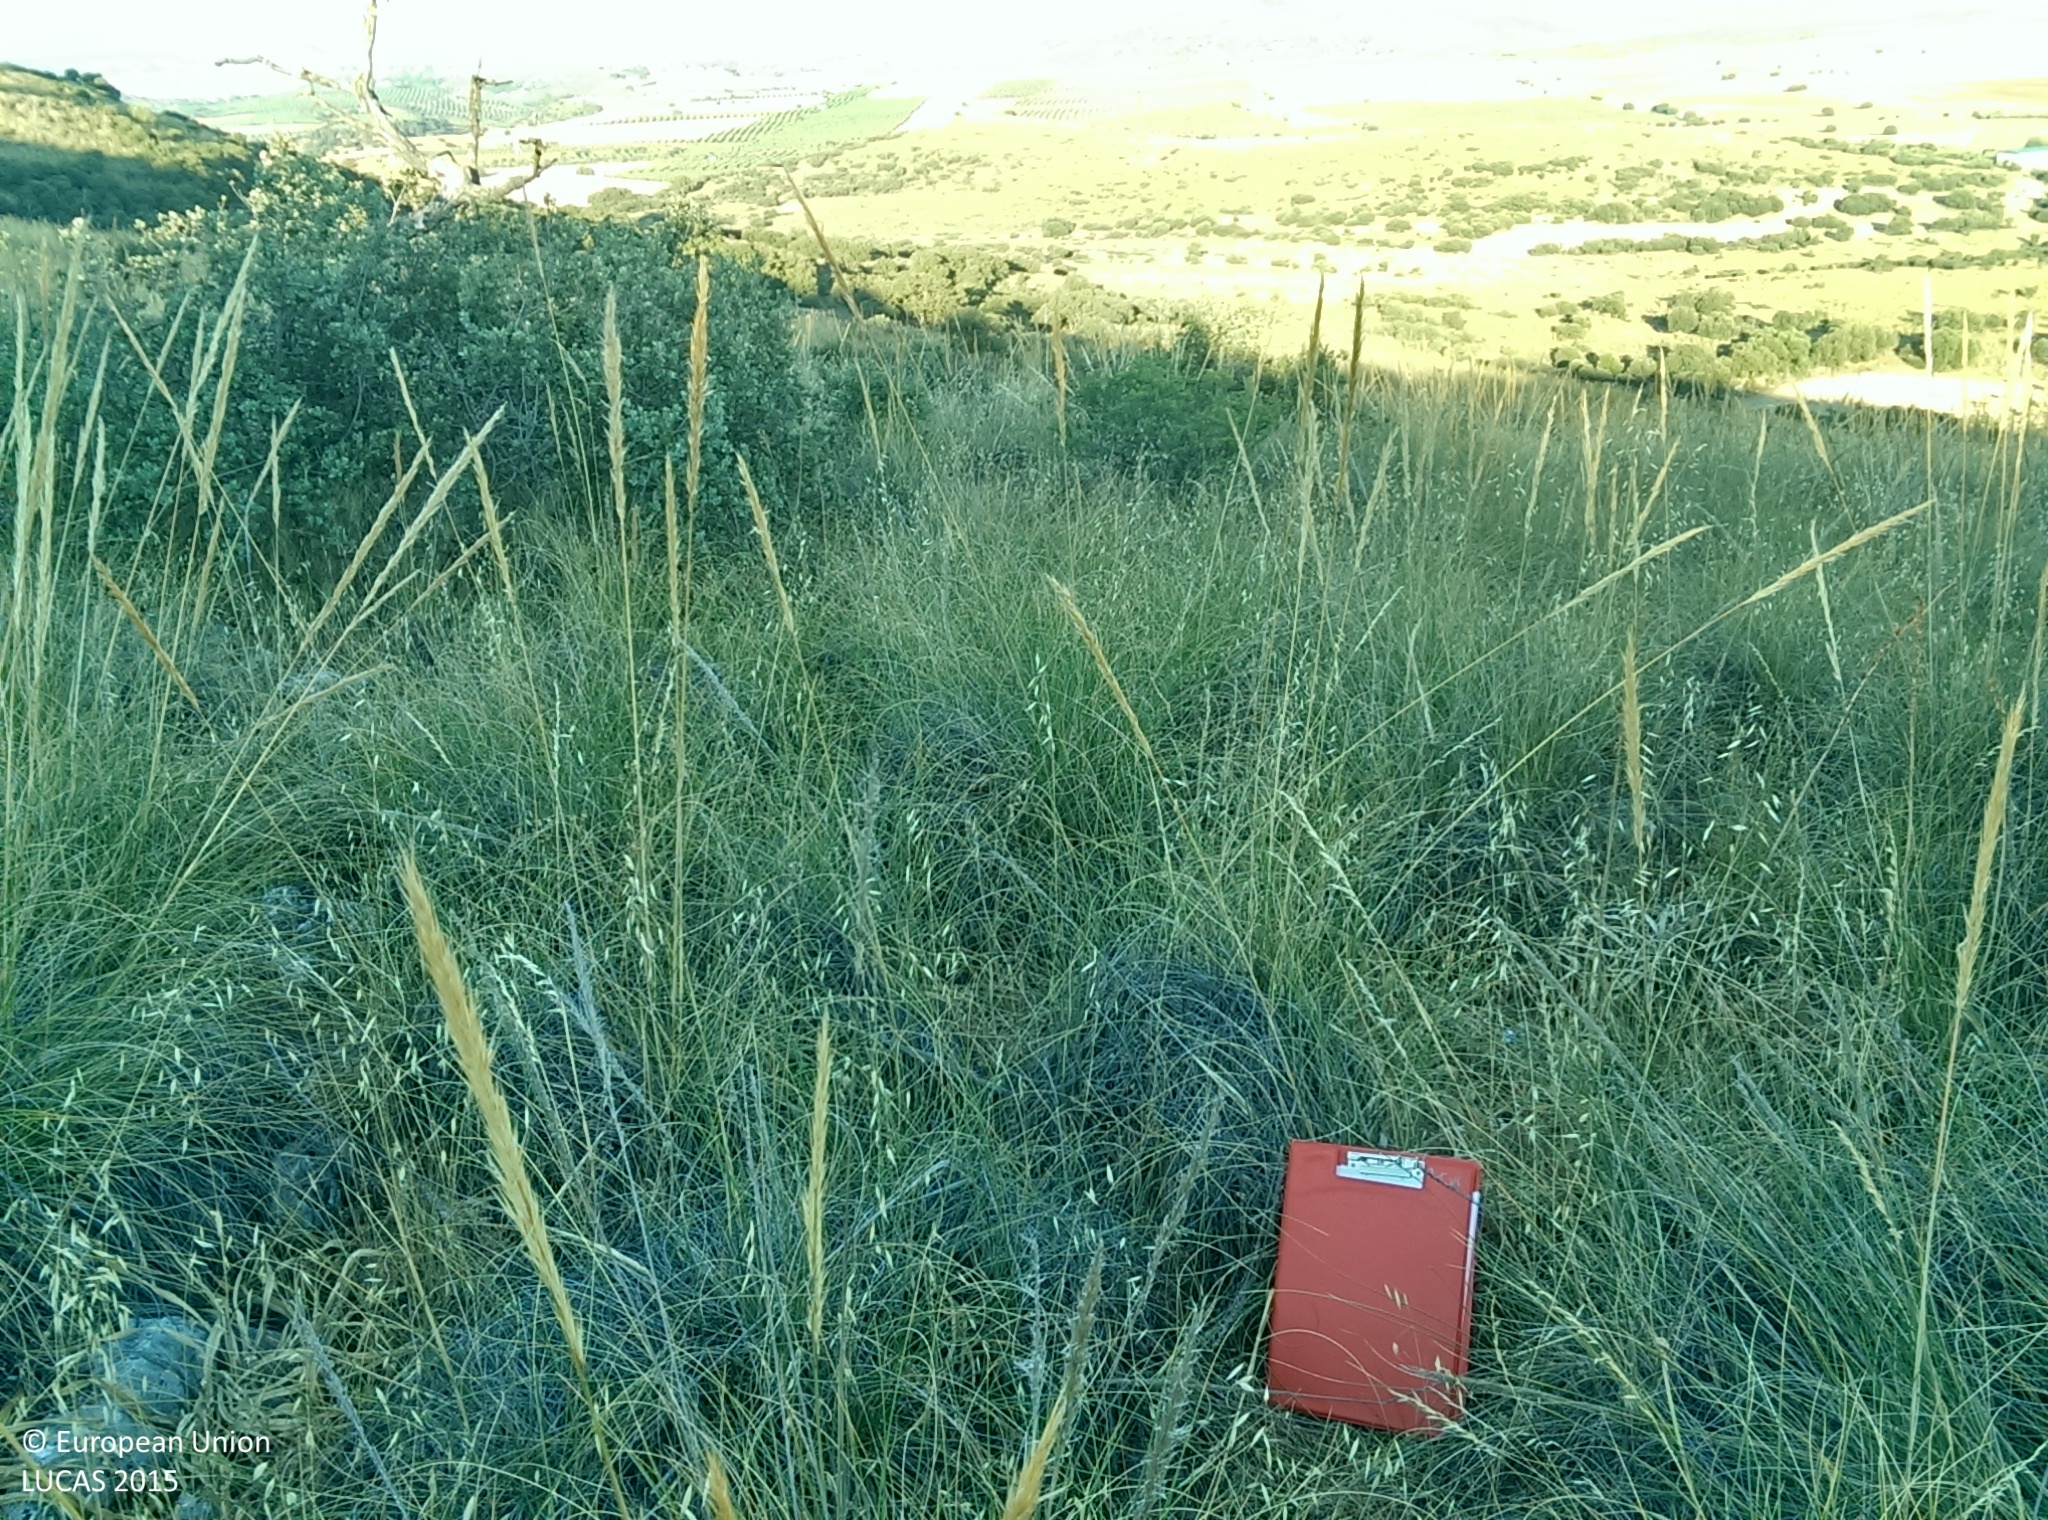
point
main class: Shrubland
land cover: Shrubland without tree cover
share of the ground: 10 - 25 %
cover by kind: herbaceous plants 80 %, shrubs 20 %
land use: Semi-natural and natural areas not in use
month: June
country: ES
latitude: 37.6334
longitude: -3.3085
